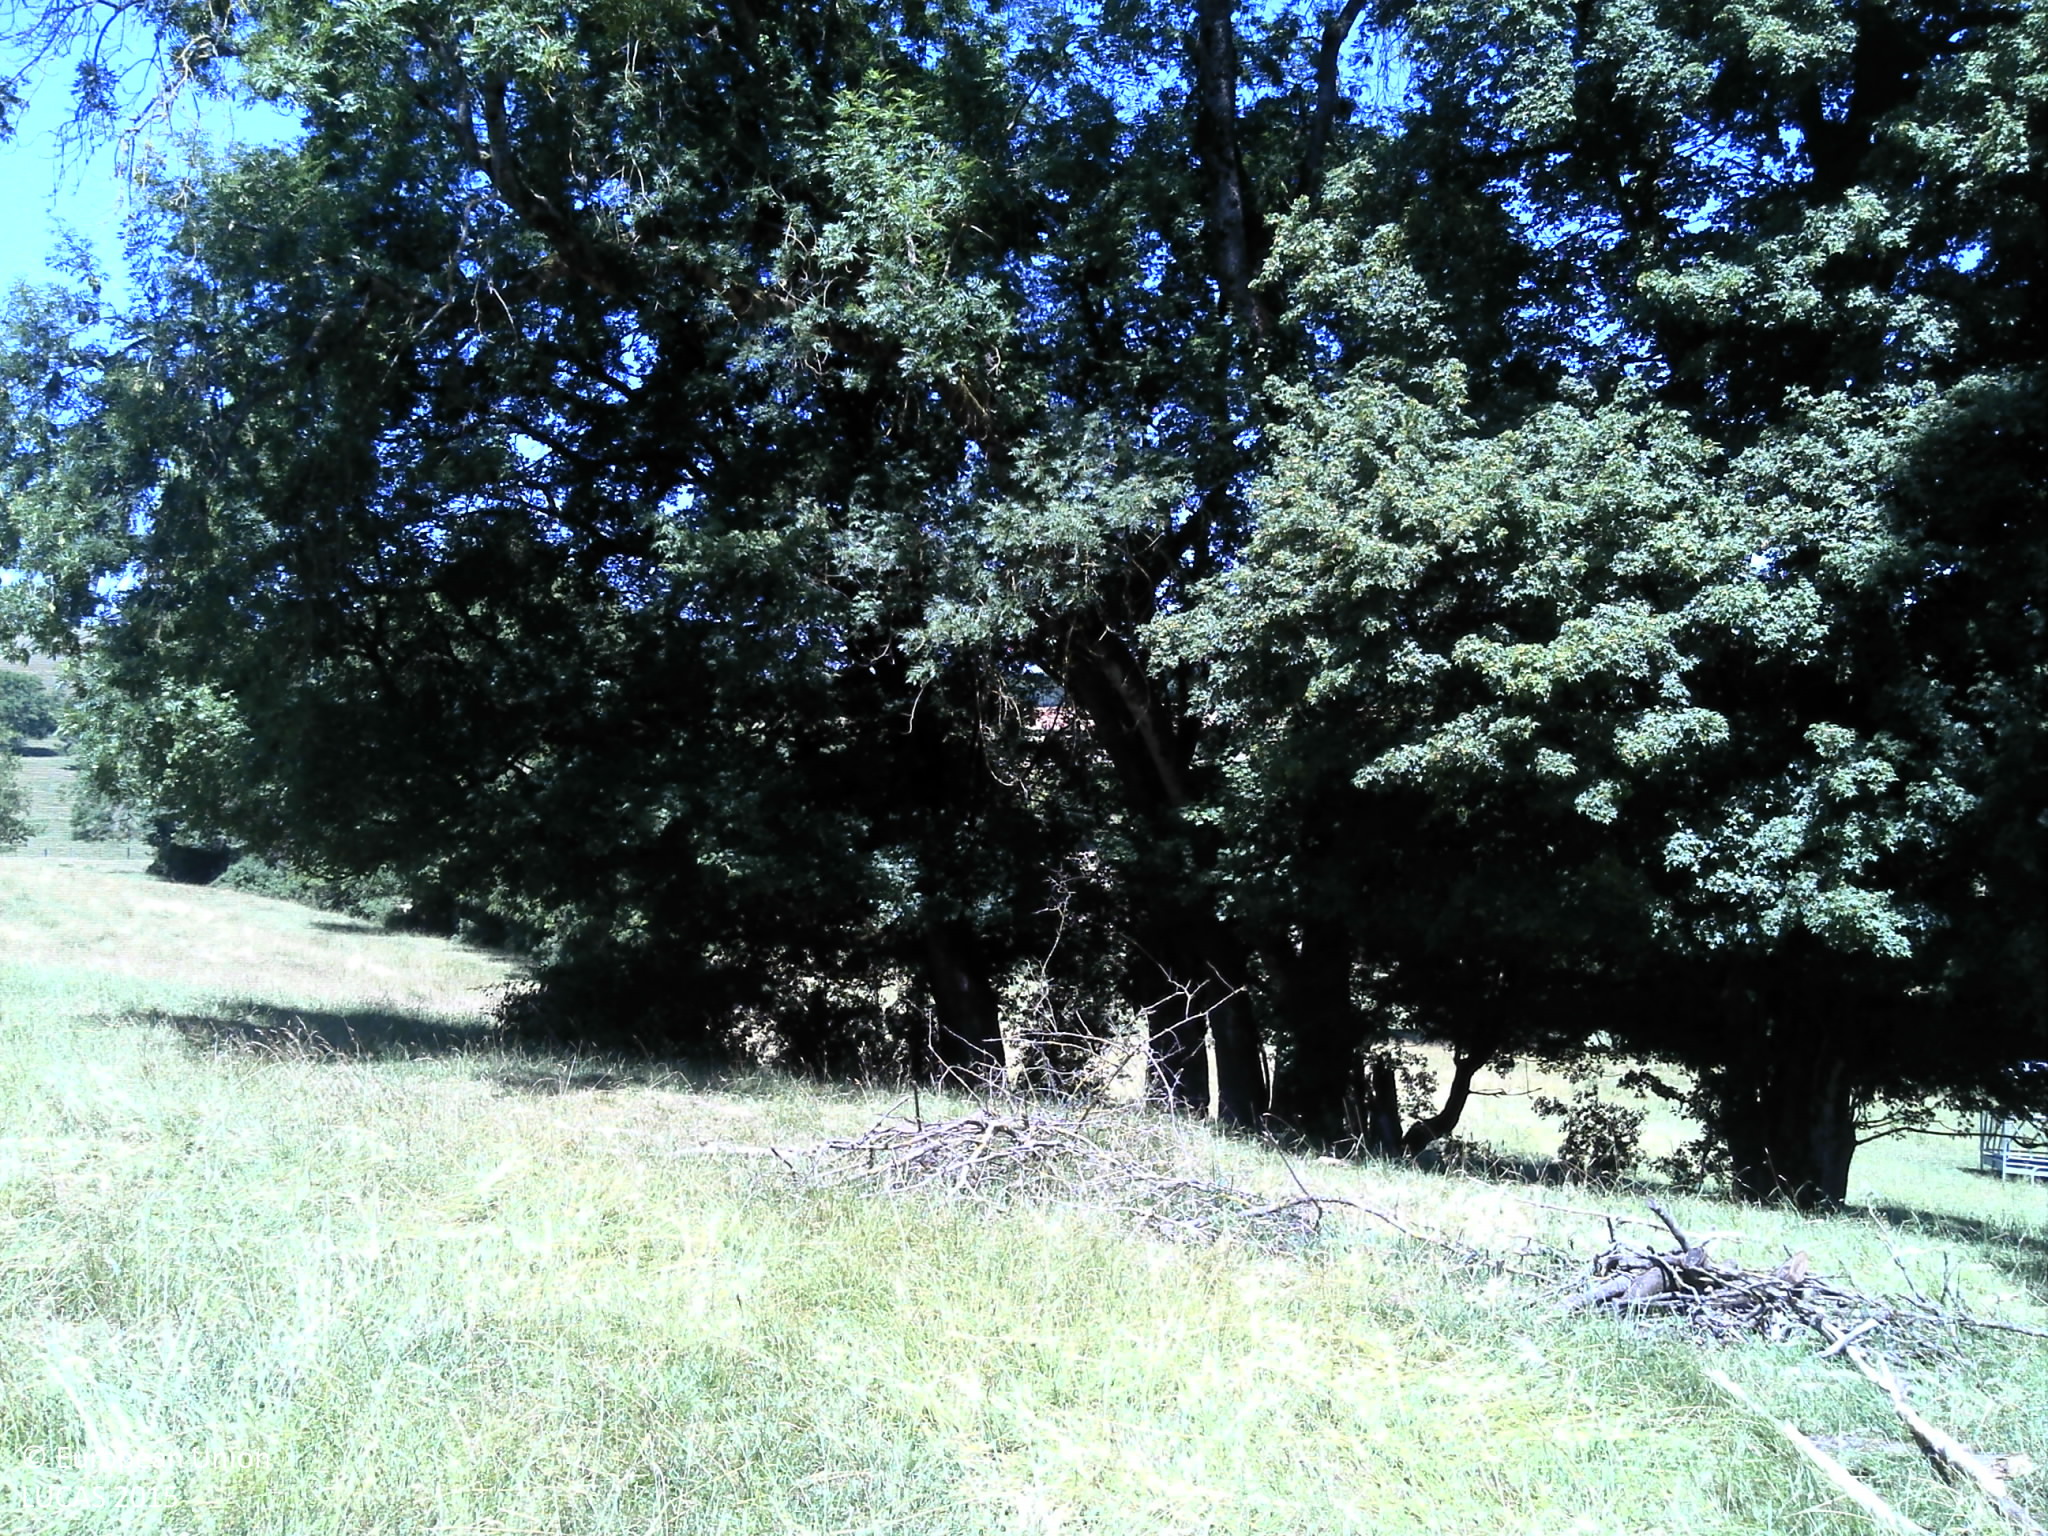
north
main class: Grassland
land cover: Grassland without tree/shrub cover
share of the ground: > 75 %
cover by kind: herbaceous plants 100 %
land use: Agriculture (excluding fallow land and kitchen gardens)
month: July
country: FR
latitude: 49.5744
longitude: 4.7002
